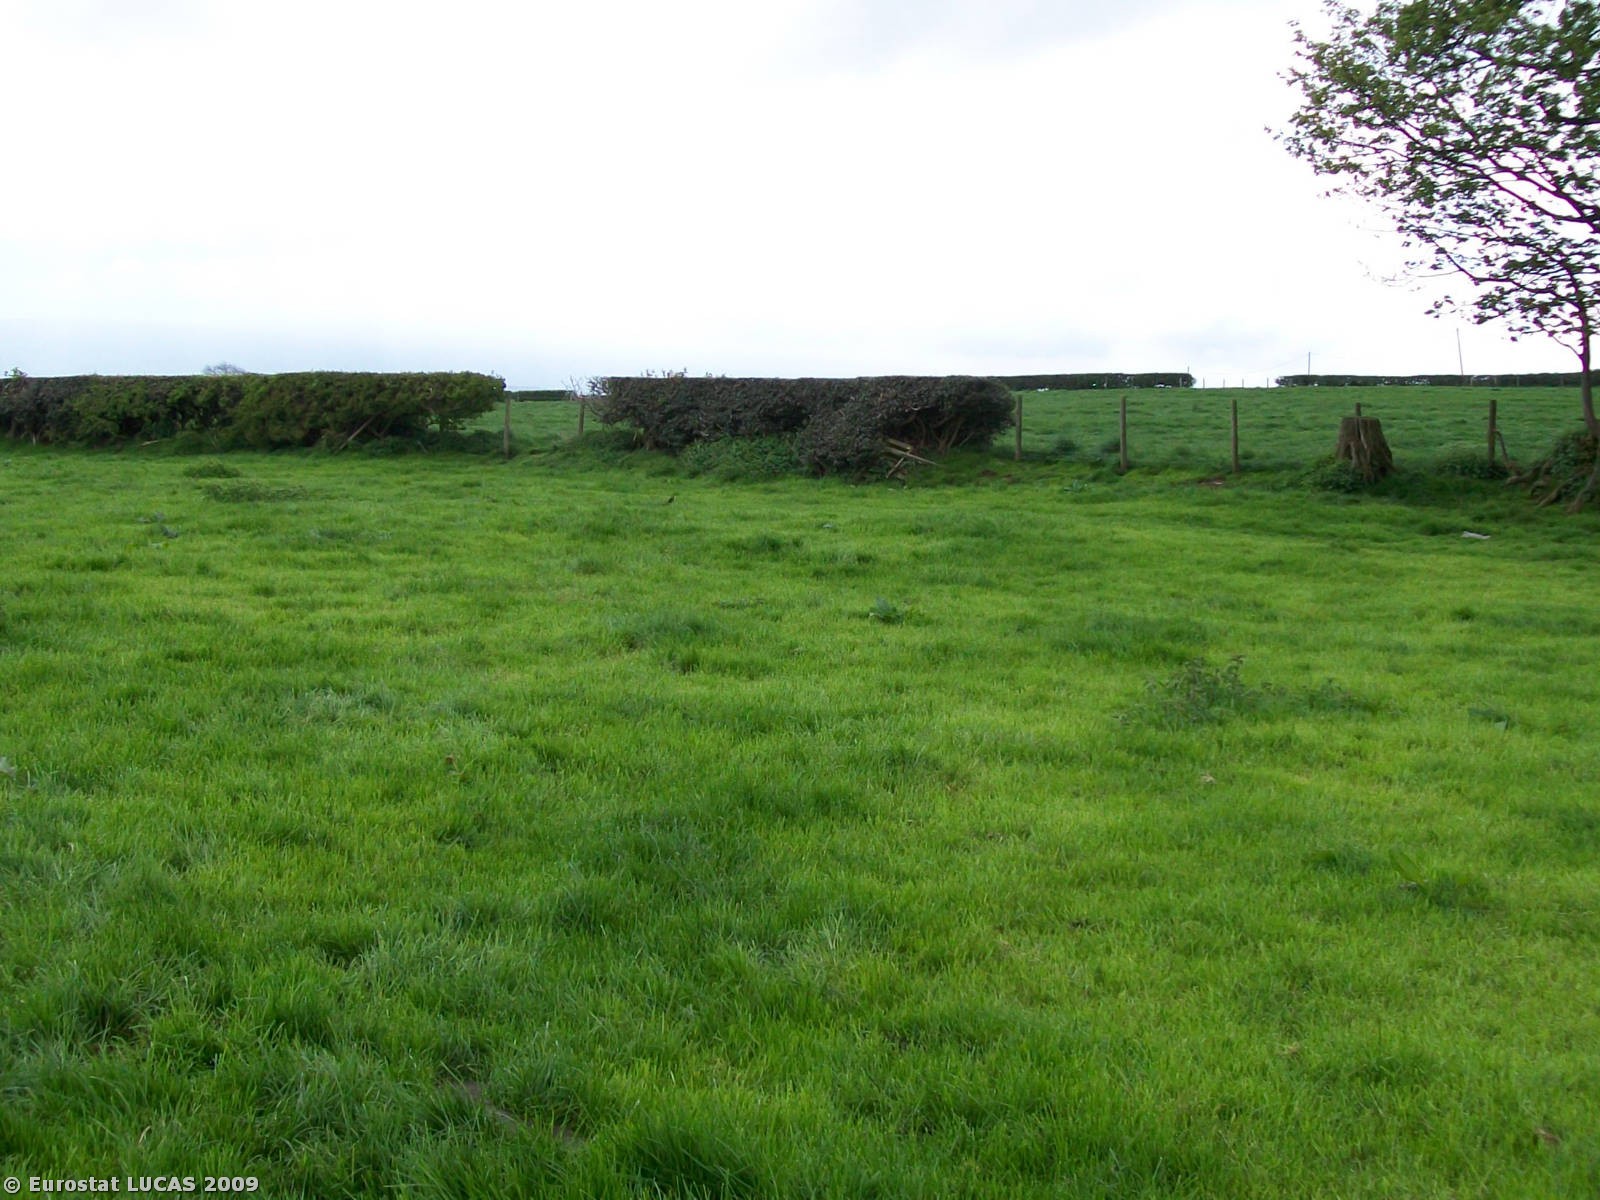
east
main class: Grassland
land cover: Grassland without tree/shrub cover
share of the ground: > 75 %
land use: Agriculture (excluding fallow land and kitchen gardens)
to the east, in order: Grassland without tree/shrub cover; Fences; Grassland without tree/shrub cover; Managed hedges; Grassland without tree/shrub cover; Managed hedges; Grassland without tree/shrub cover
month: April
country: GB
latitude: 53.2229
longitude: -3.5195
